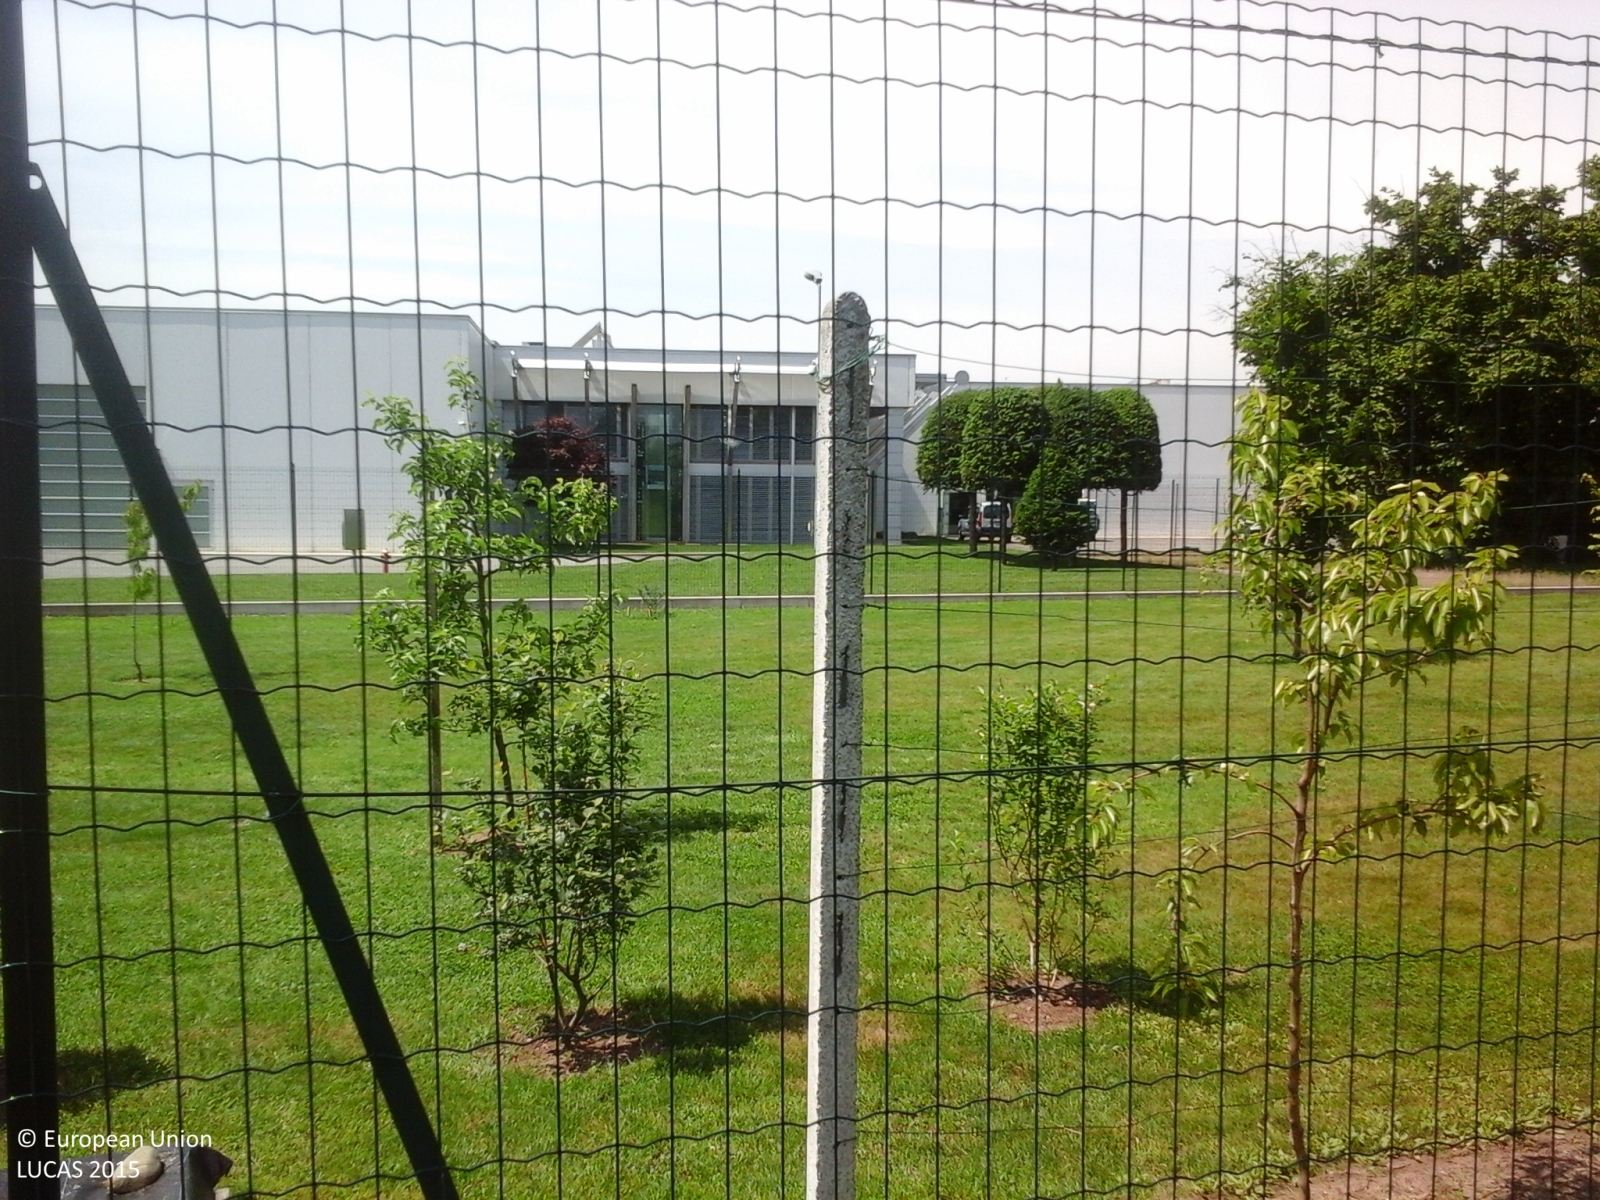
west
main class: Grassland
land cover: Grassland with sparse tree/shrub cover
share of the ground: > 75 %
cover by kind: herbaceous plants 95 %, broadleaved forest trees 5 %
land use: Other primary production
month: May
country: IT
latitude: 45.7273
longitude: 8.4476
